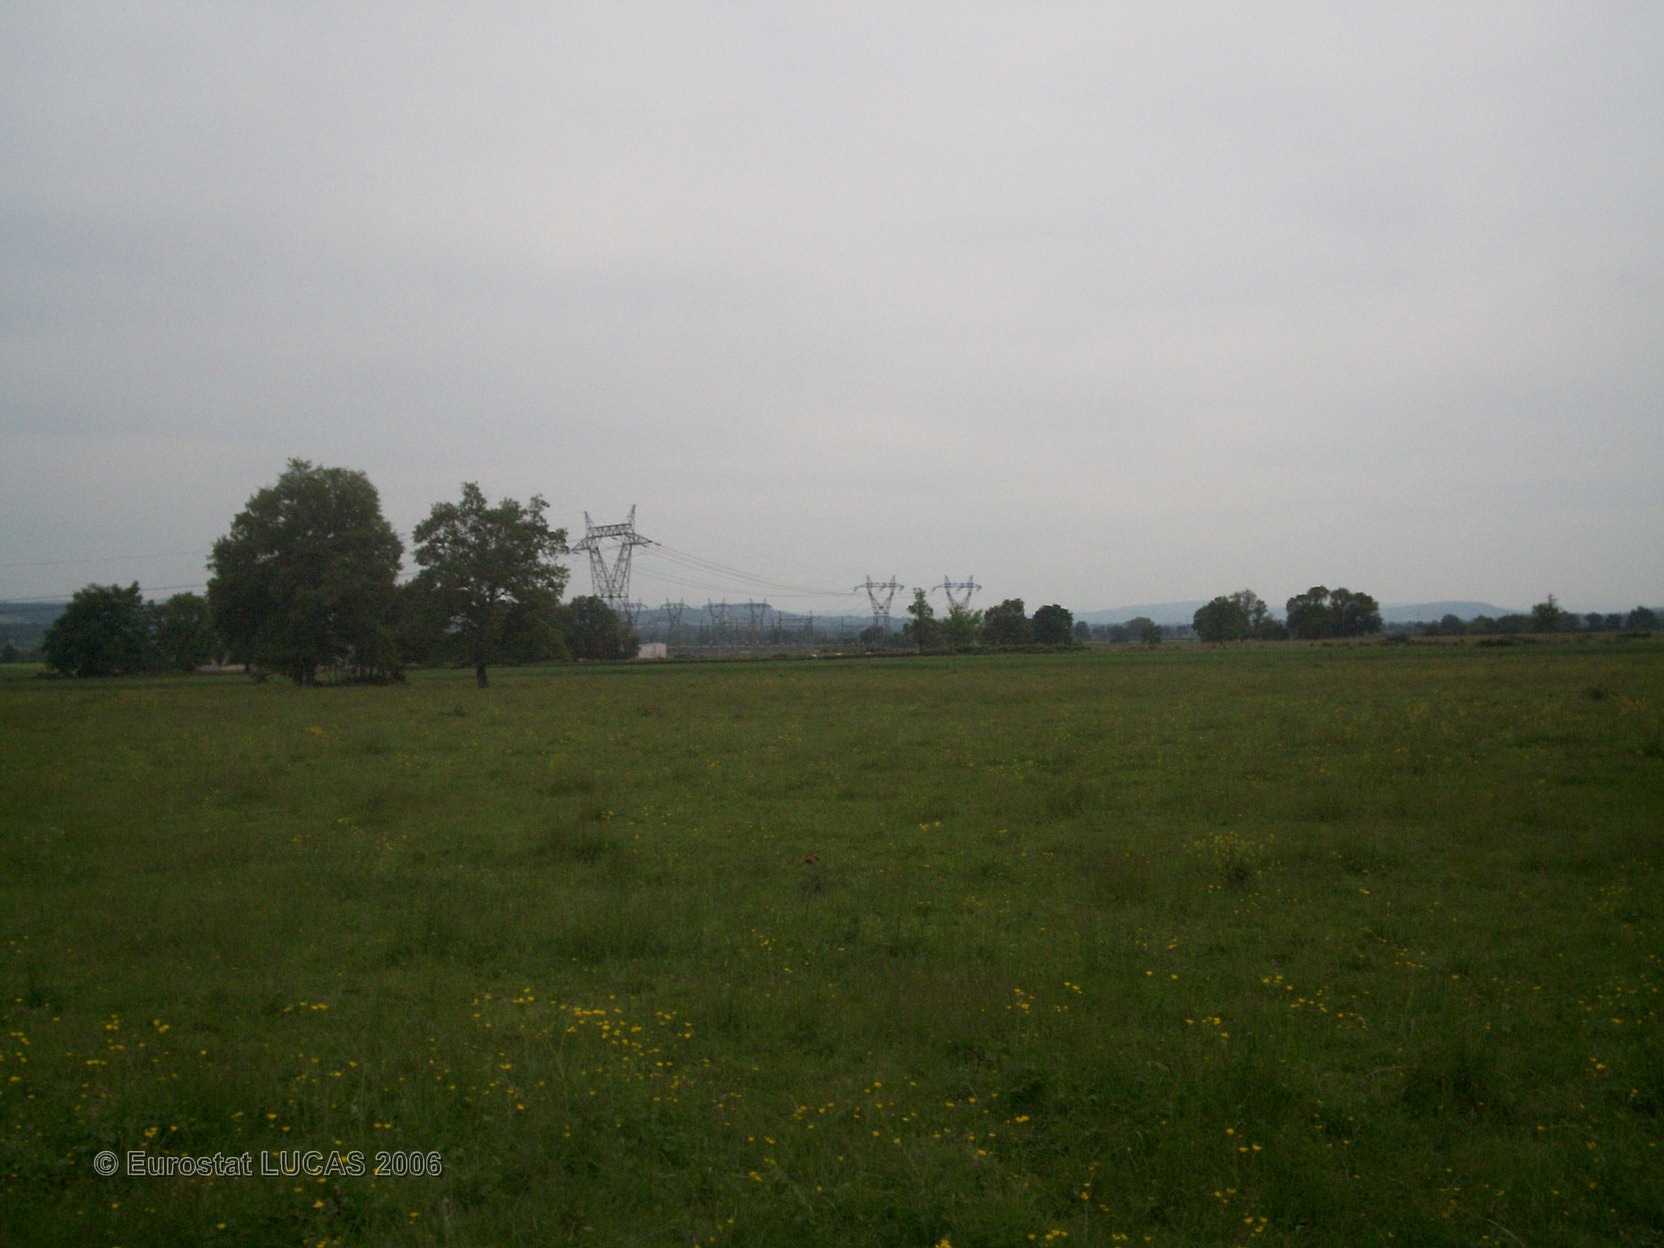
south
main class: Grassland
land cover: Grassland with sparse tree/shrub cover
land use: Agriculture (excluding fallow land and kitchen gardens)
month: May
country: FR
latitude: 46.6355
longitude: 4.7110
